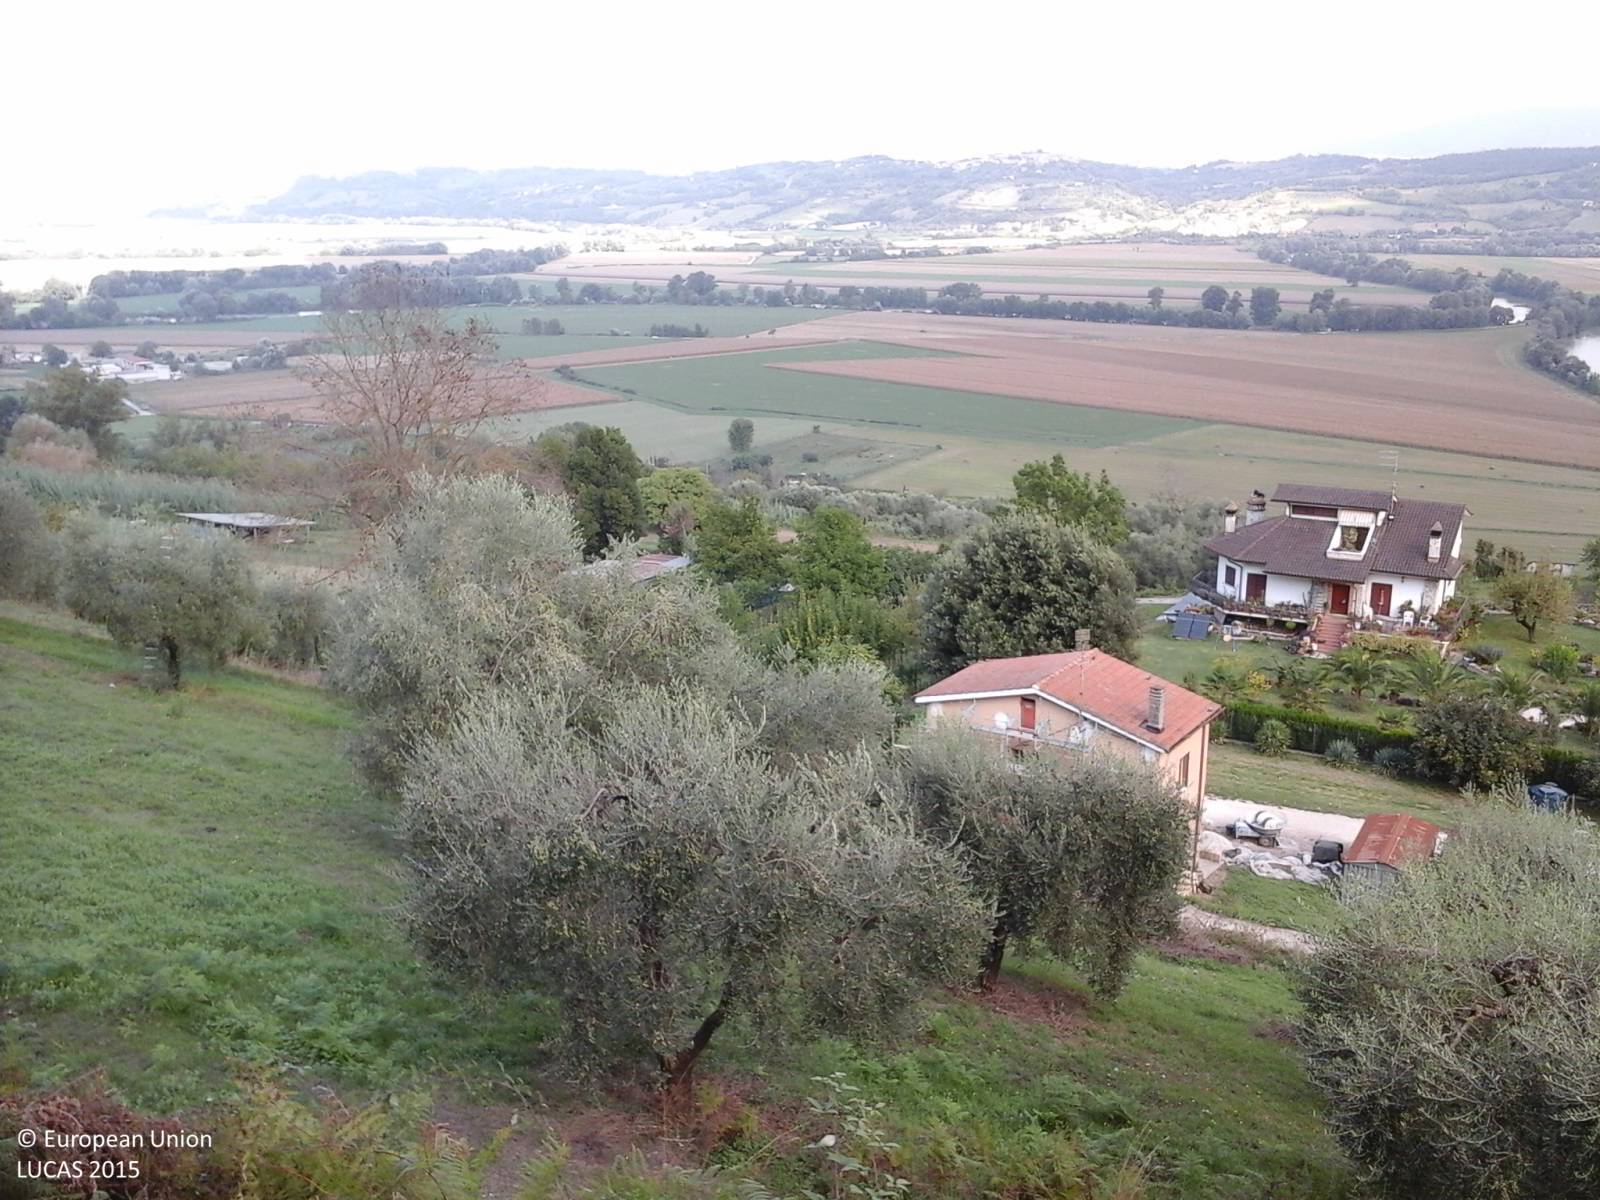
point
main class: Cropland
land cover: Olive groves
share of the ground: 50 - 75 %
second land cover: Spontaneously vegetated surfaces
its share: > 75 %
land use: Kitchen garden
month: September
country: IT
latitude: 42.2599
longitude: 12.5732
